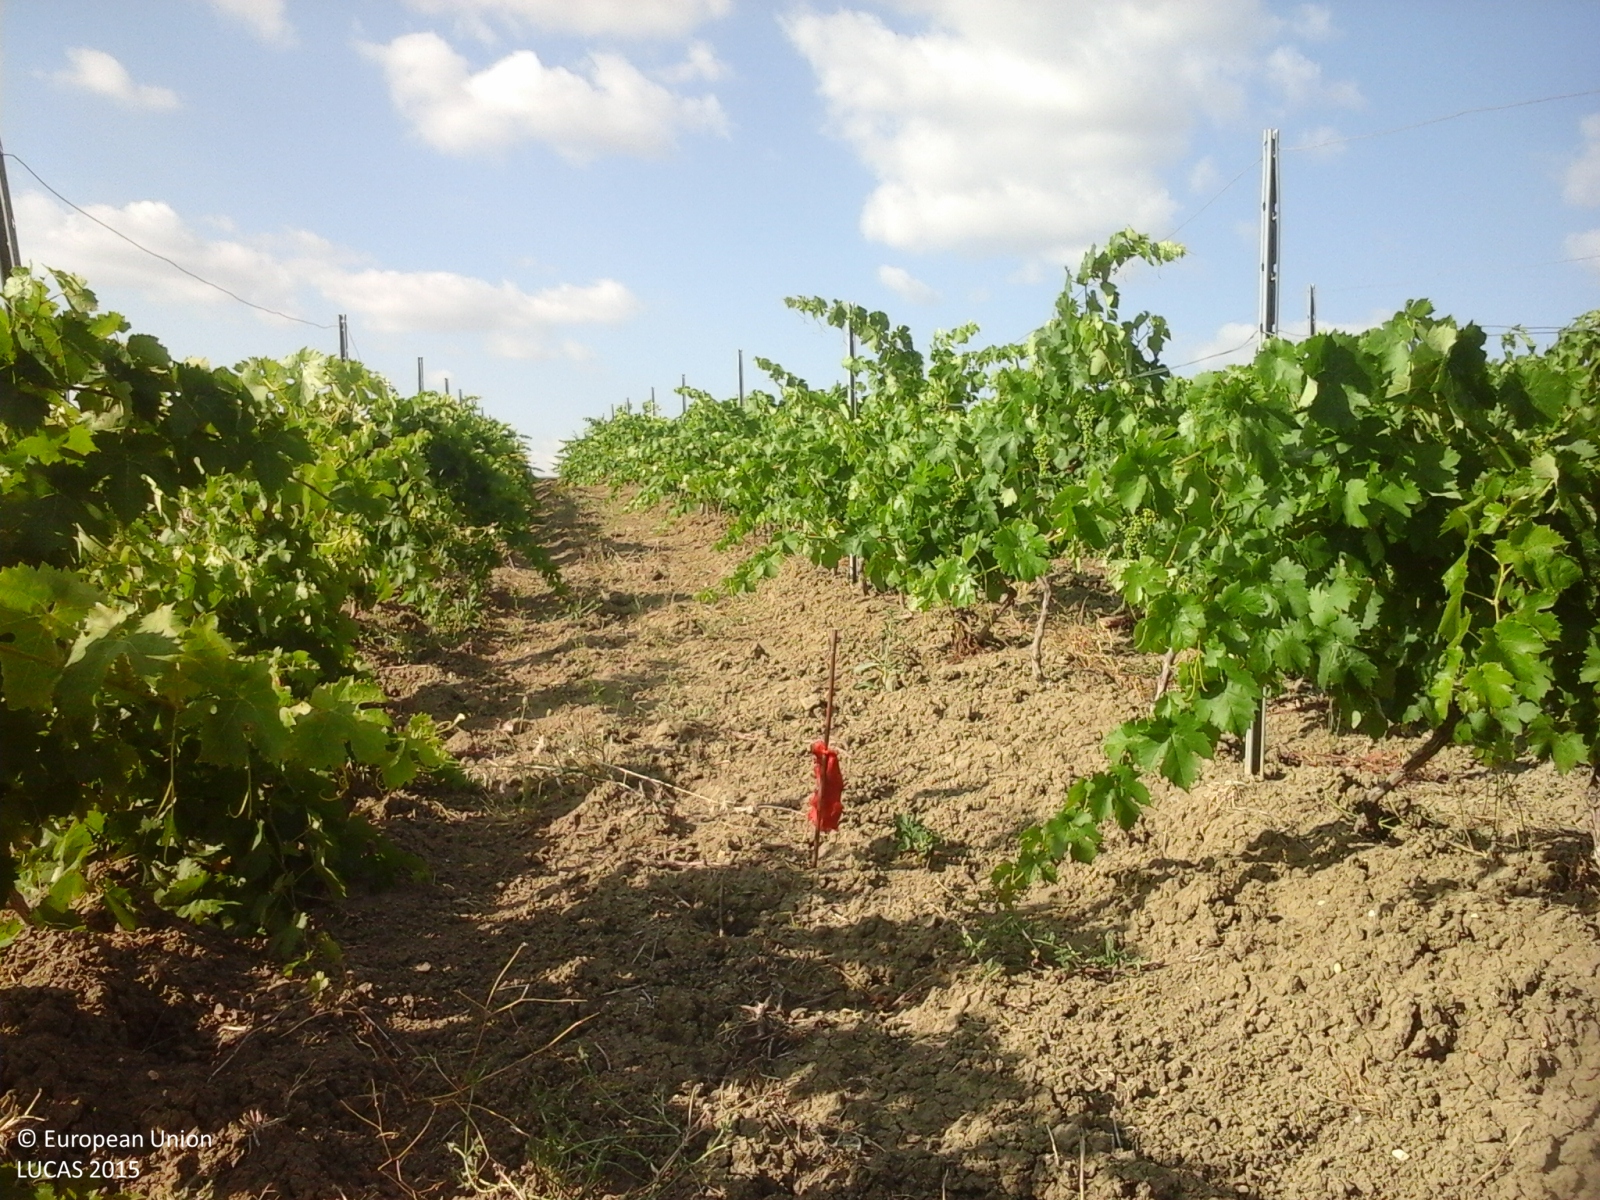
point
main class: Cropland
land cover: Vineyards
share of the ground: 25 - 50 %
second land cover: Other bare soil
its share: > 75 %
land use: Agriculture (excluding fallow land and kitchen gardens)
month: June
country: IT
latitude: 37.6979
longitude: 13.0732
